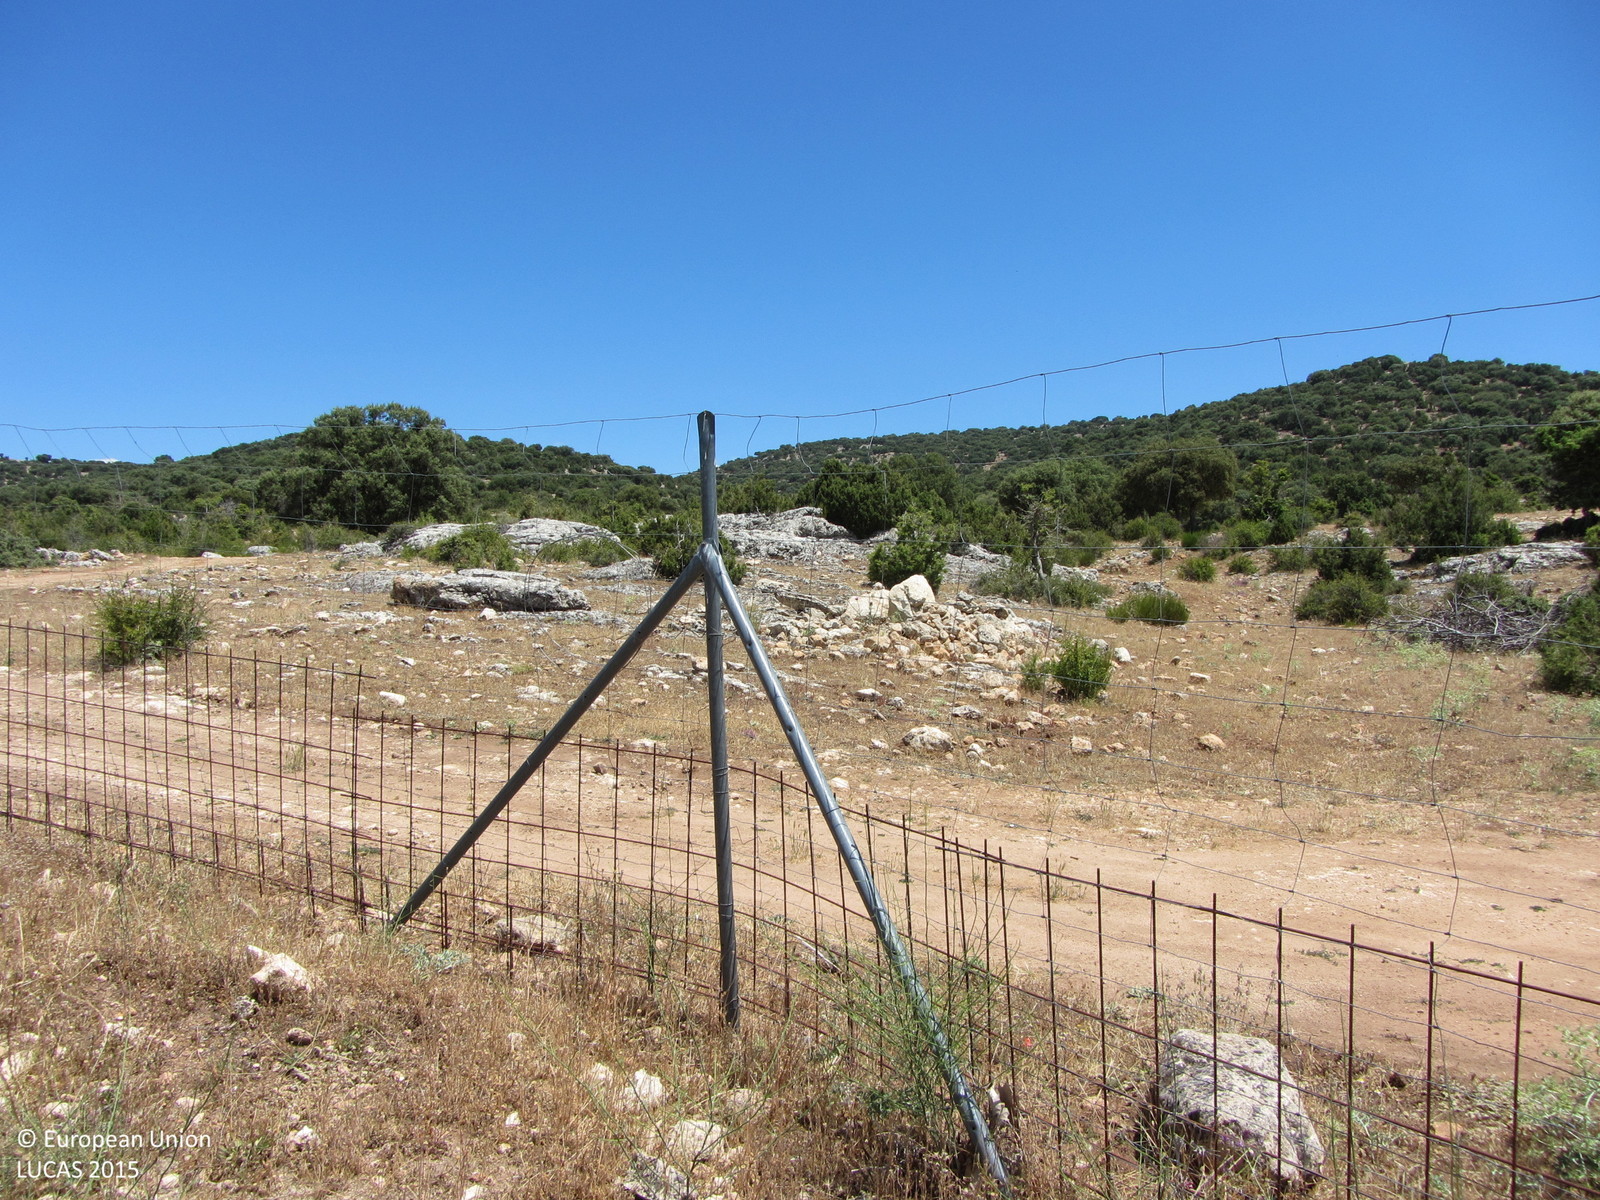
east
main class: Woodland
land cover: Broadleaved woodland
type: broadleaved evergreen forest
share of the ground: > 75 %
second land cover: Shrubland without tree cover
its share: 10 - 25 %
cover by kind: broadleaved forest trees 80 %, shrubs 10 %, consolidated bare surface 10 %
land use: Forestry
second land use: Agriculture (excluding fallow land and kitchen gardens)
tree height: > 5 m
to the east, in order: Broadleaved woodland; Shrubland without tree cover
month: June
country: ES
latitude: 38.1779
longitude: -2.4028
